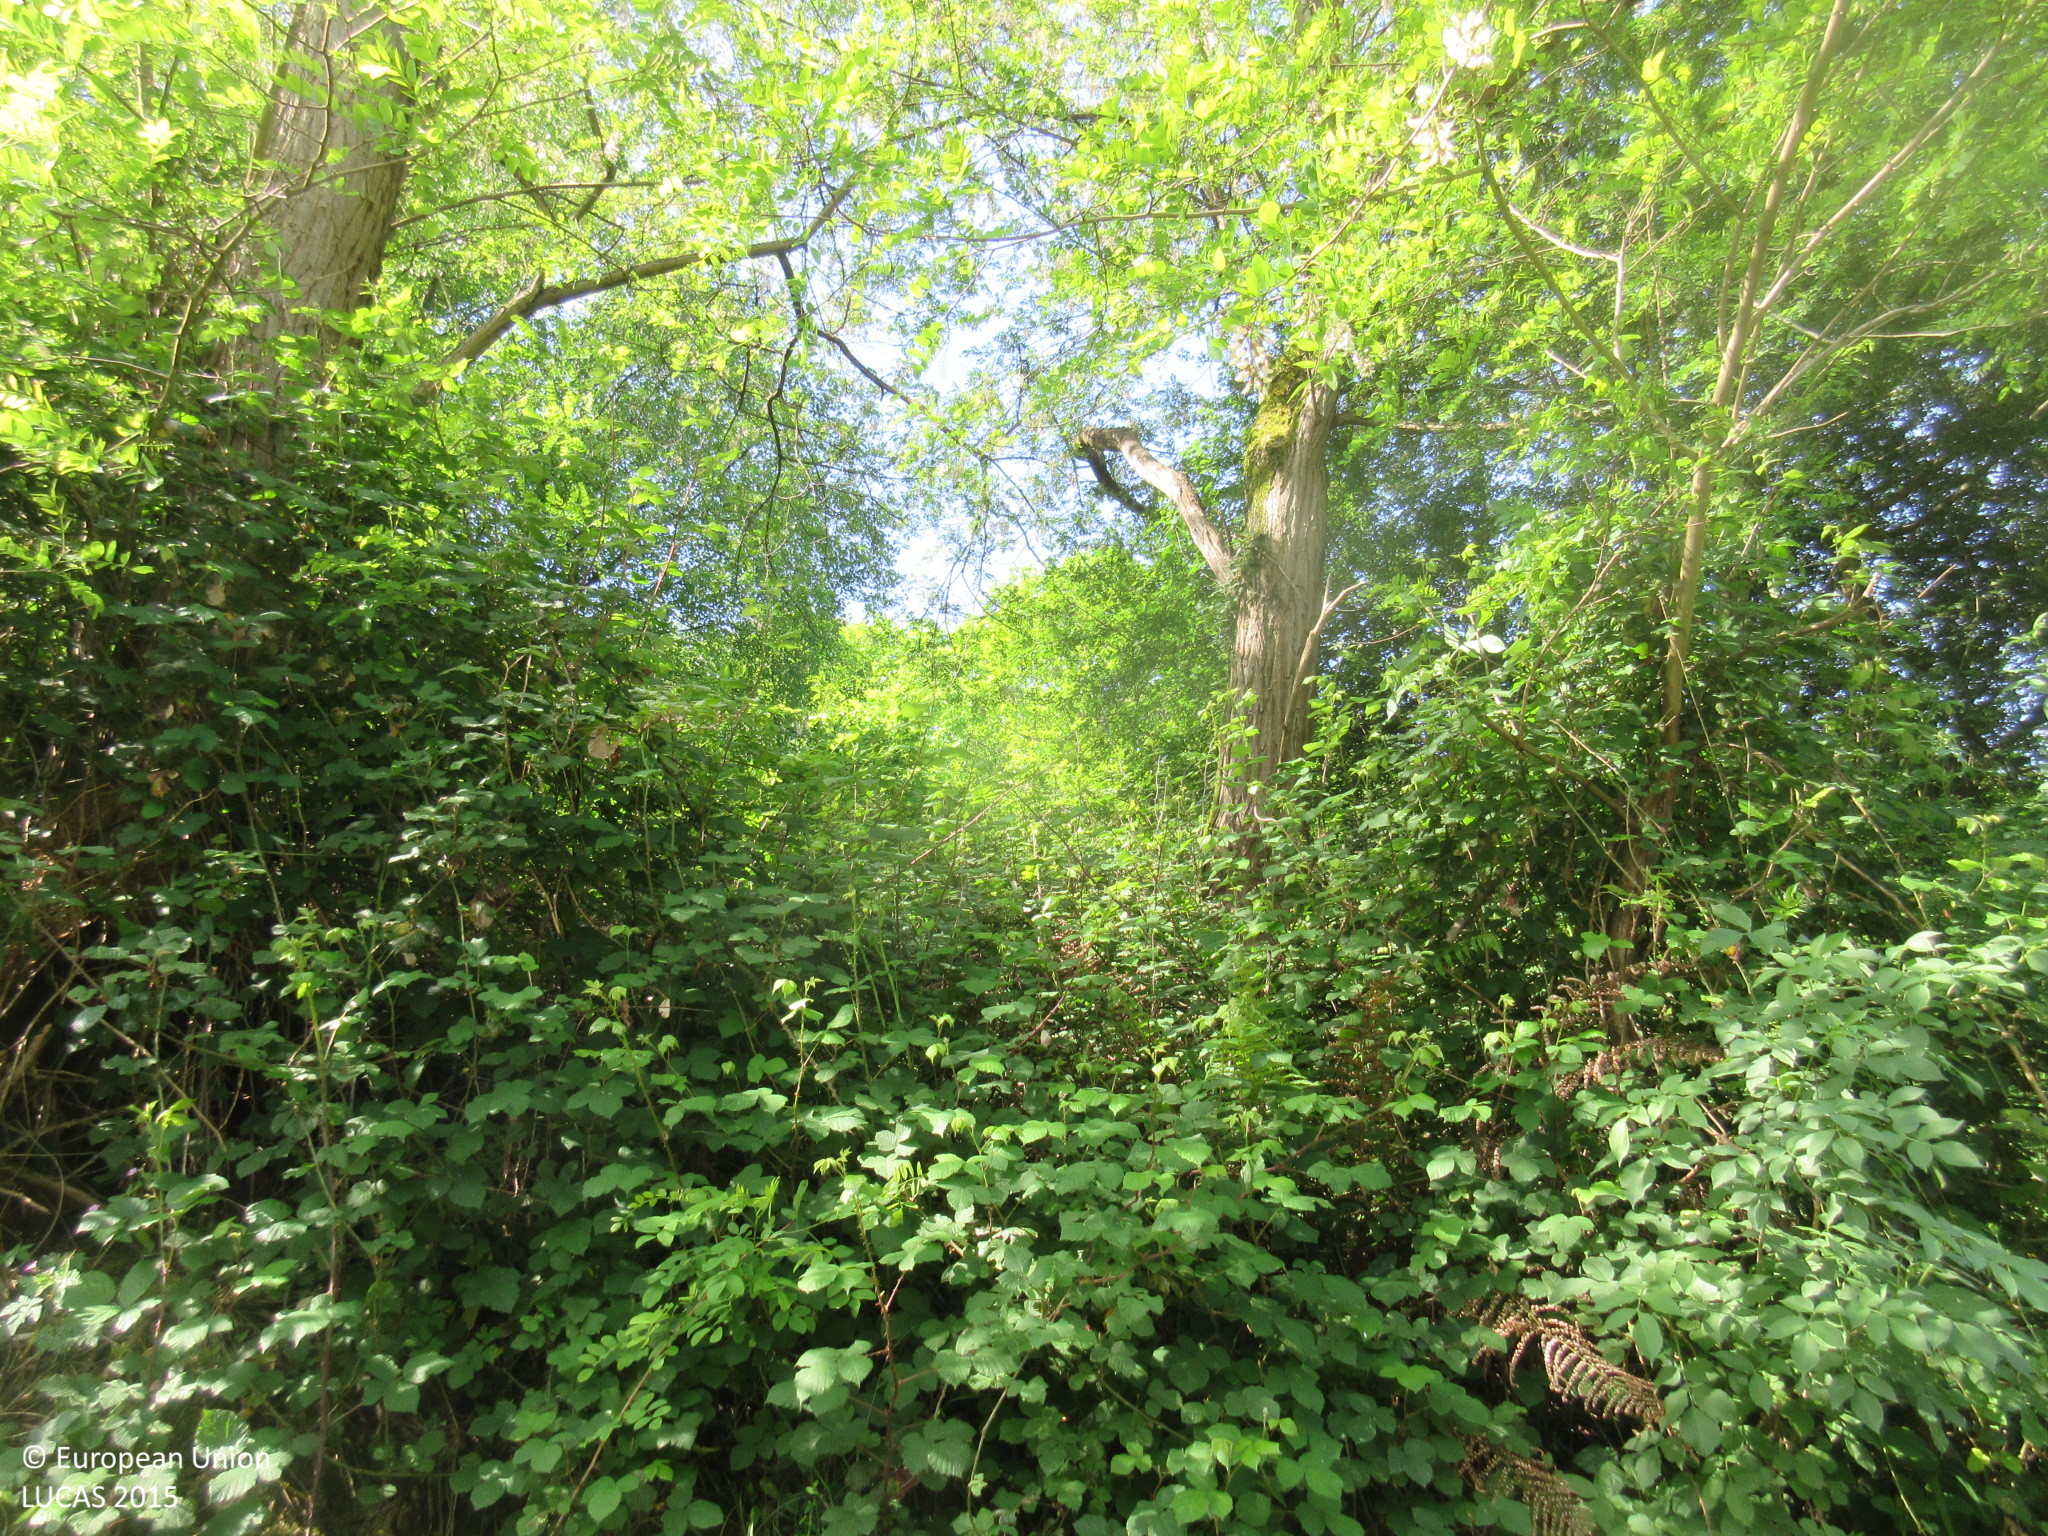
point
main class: Woodland
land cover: Broadleaved woodland
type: thermophilous deciduous forest
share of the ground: > 75 %
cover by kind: broadleaved forest trees 95 %, shrubs 5 %
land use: Forestry
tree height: > 5 m
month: May
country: ES
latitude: 43.2430
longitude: -5.7871
